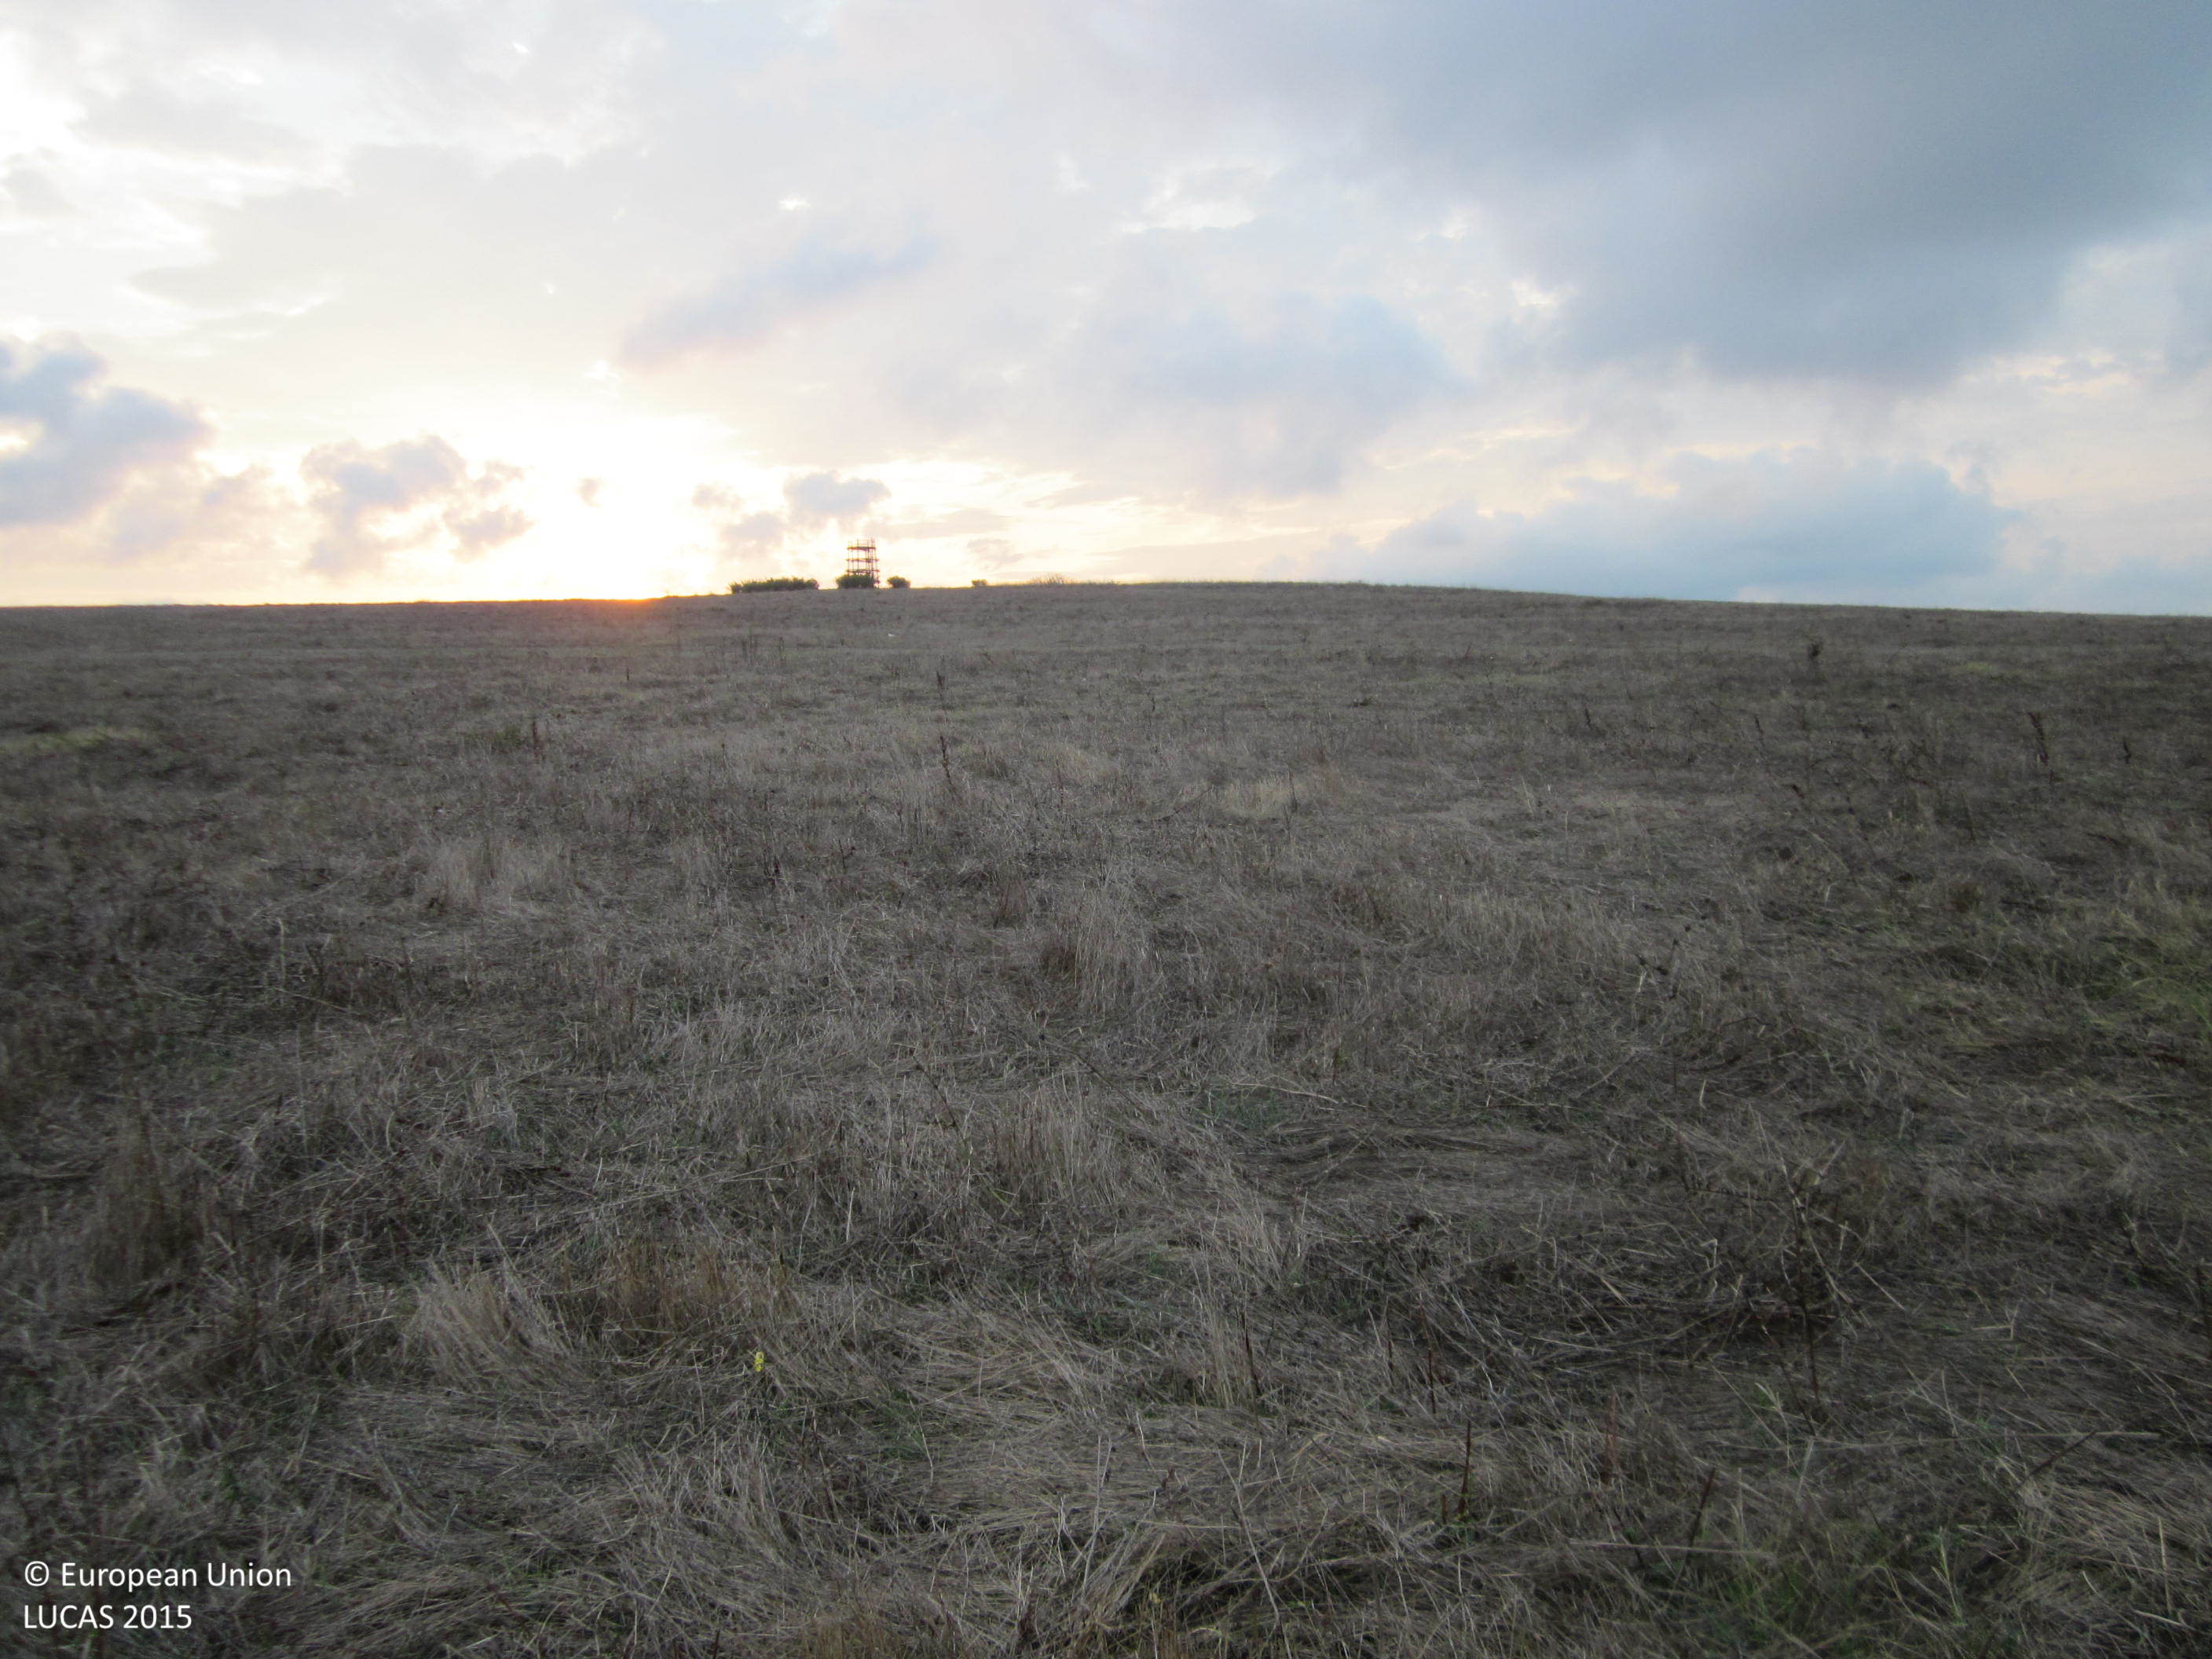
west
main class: Grassland
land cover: Grassland without tree/shrub cover
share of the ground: > 75 %
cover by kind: herbaceous plants 100 %
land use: Agriculture (excluding fallow land and kitchen gardens)
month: September
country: BG
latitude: 42.3769
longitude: 27.6699
